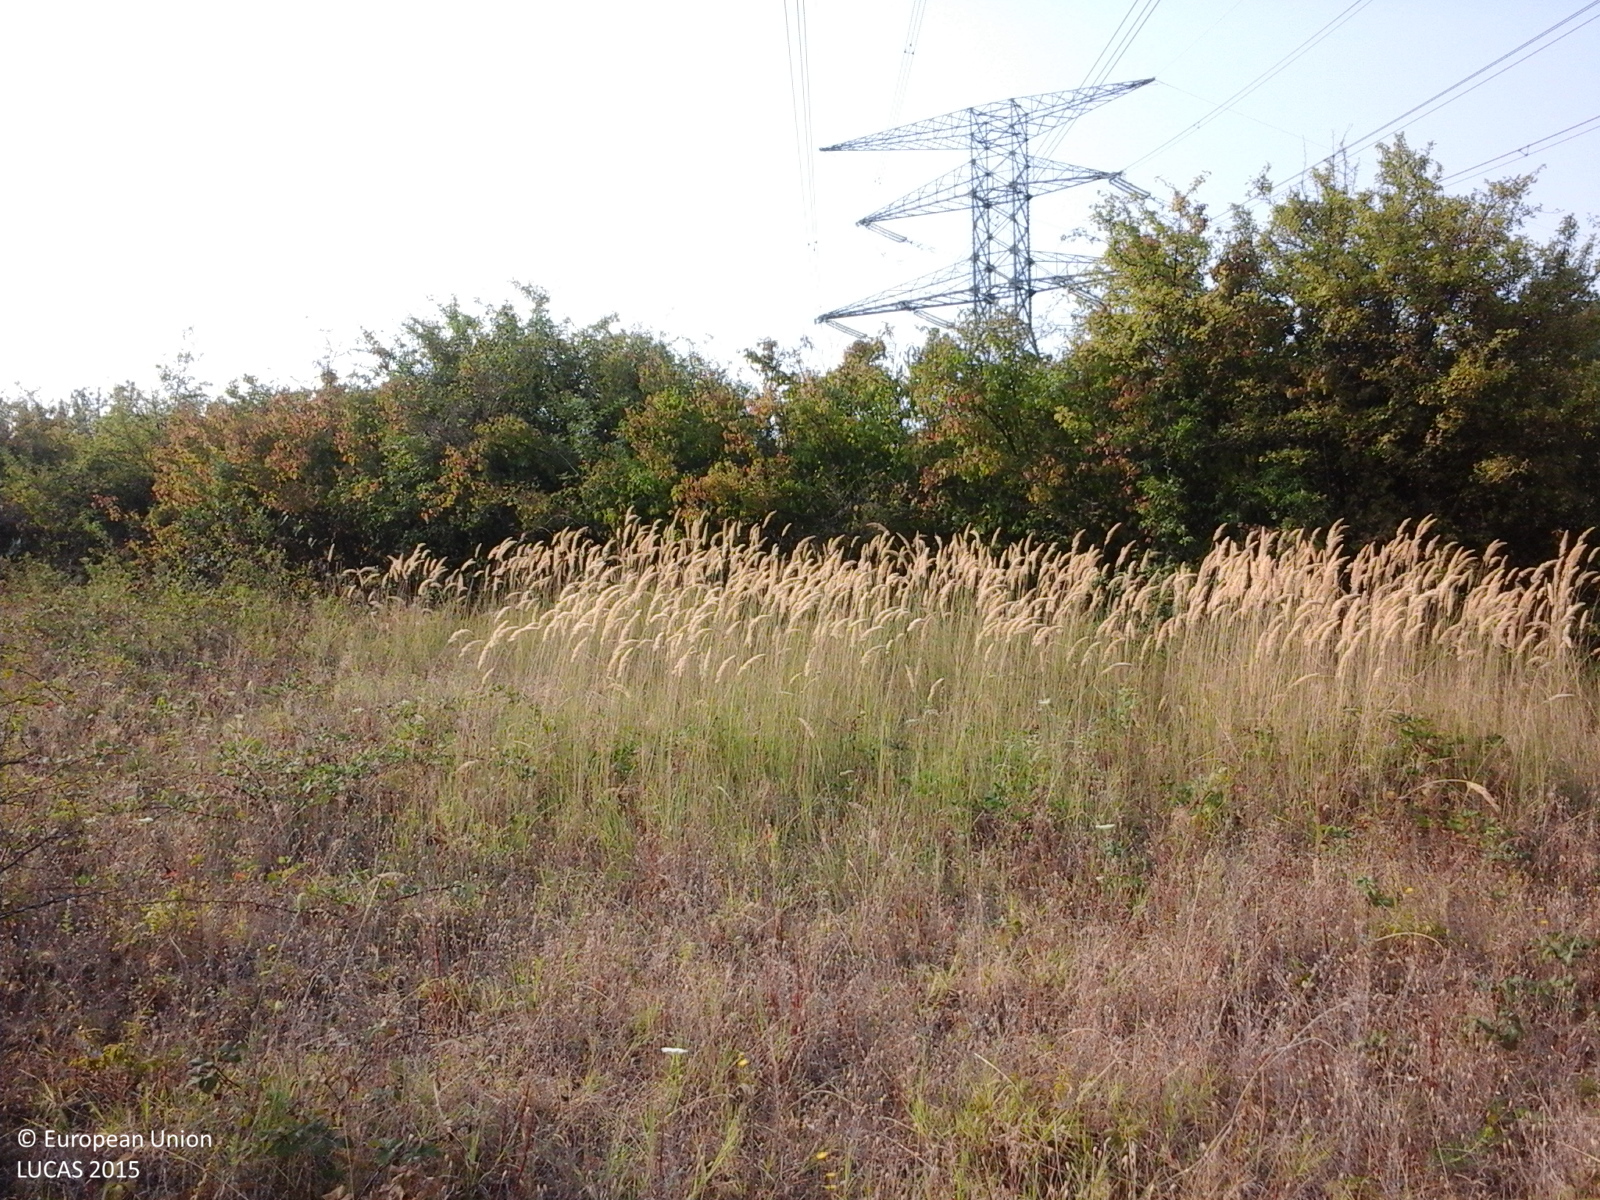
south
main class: Artificial land
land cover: Non built-up area features
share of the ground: > 75 %
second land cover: Spontaneously vegetated surfaces
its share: > 75 %
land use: Electricity, gas and thermal power distribution
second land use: Agriculture (excluding fallow land and kitchen gardens)
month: August
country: RO
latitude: 44.4630
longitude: 23.5403
